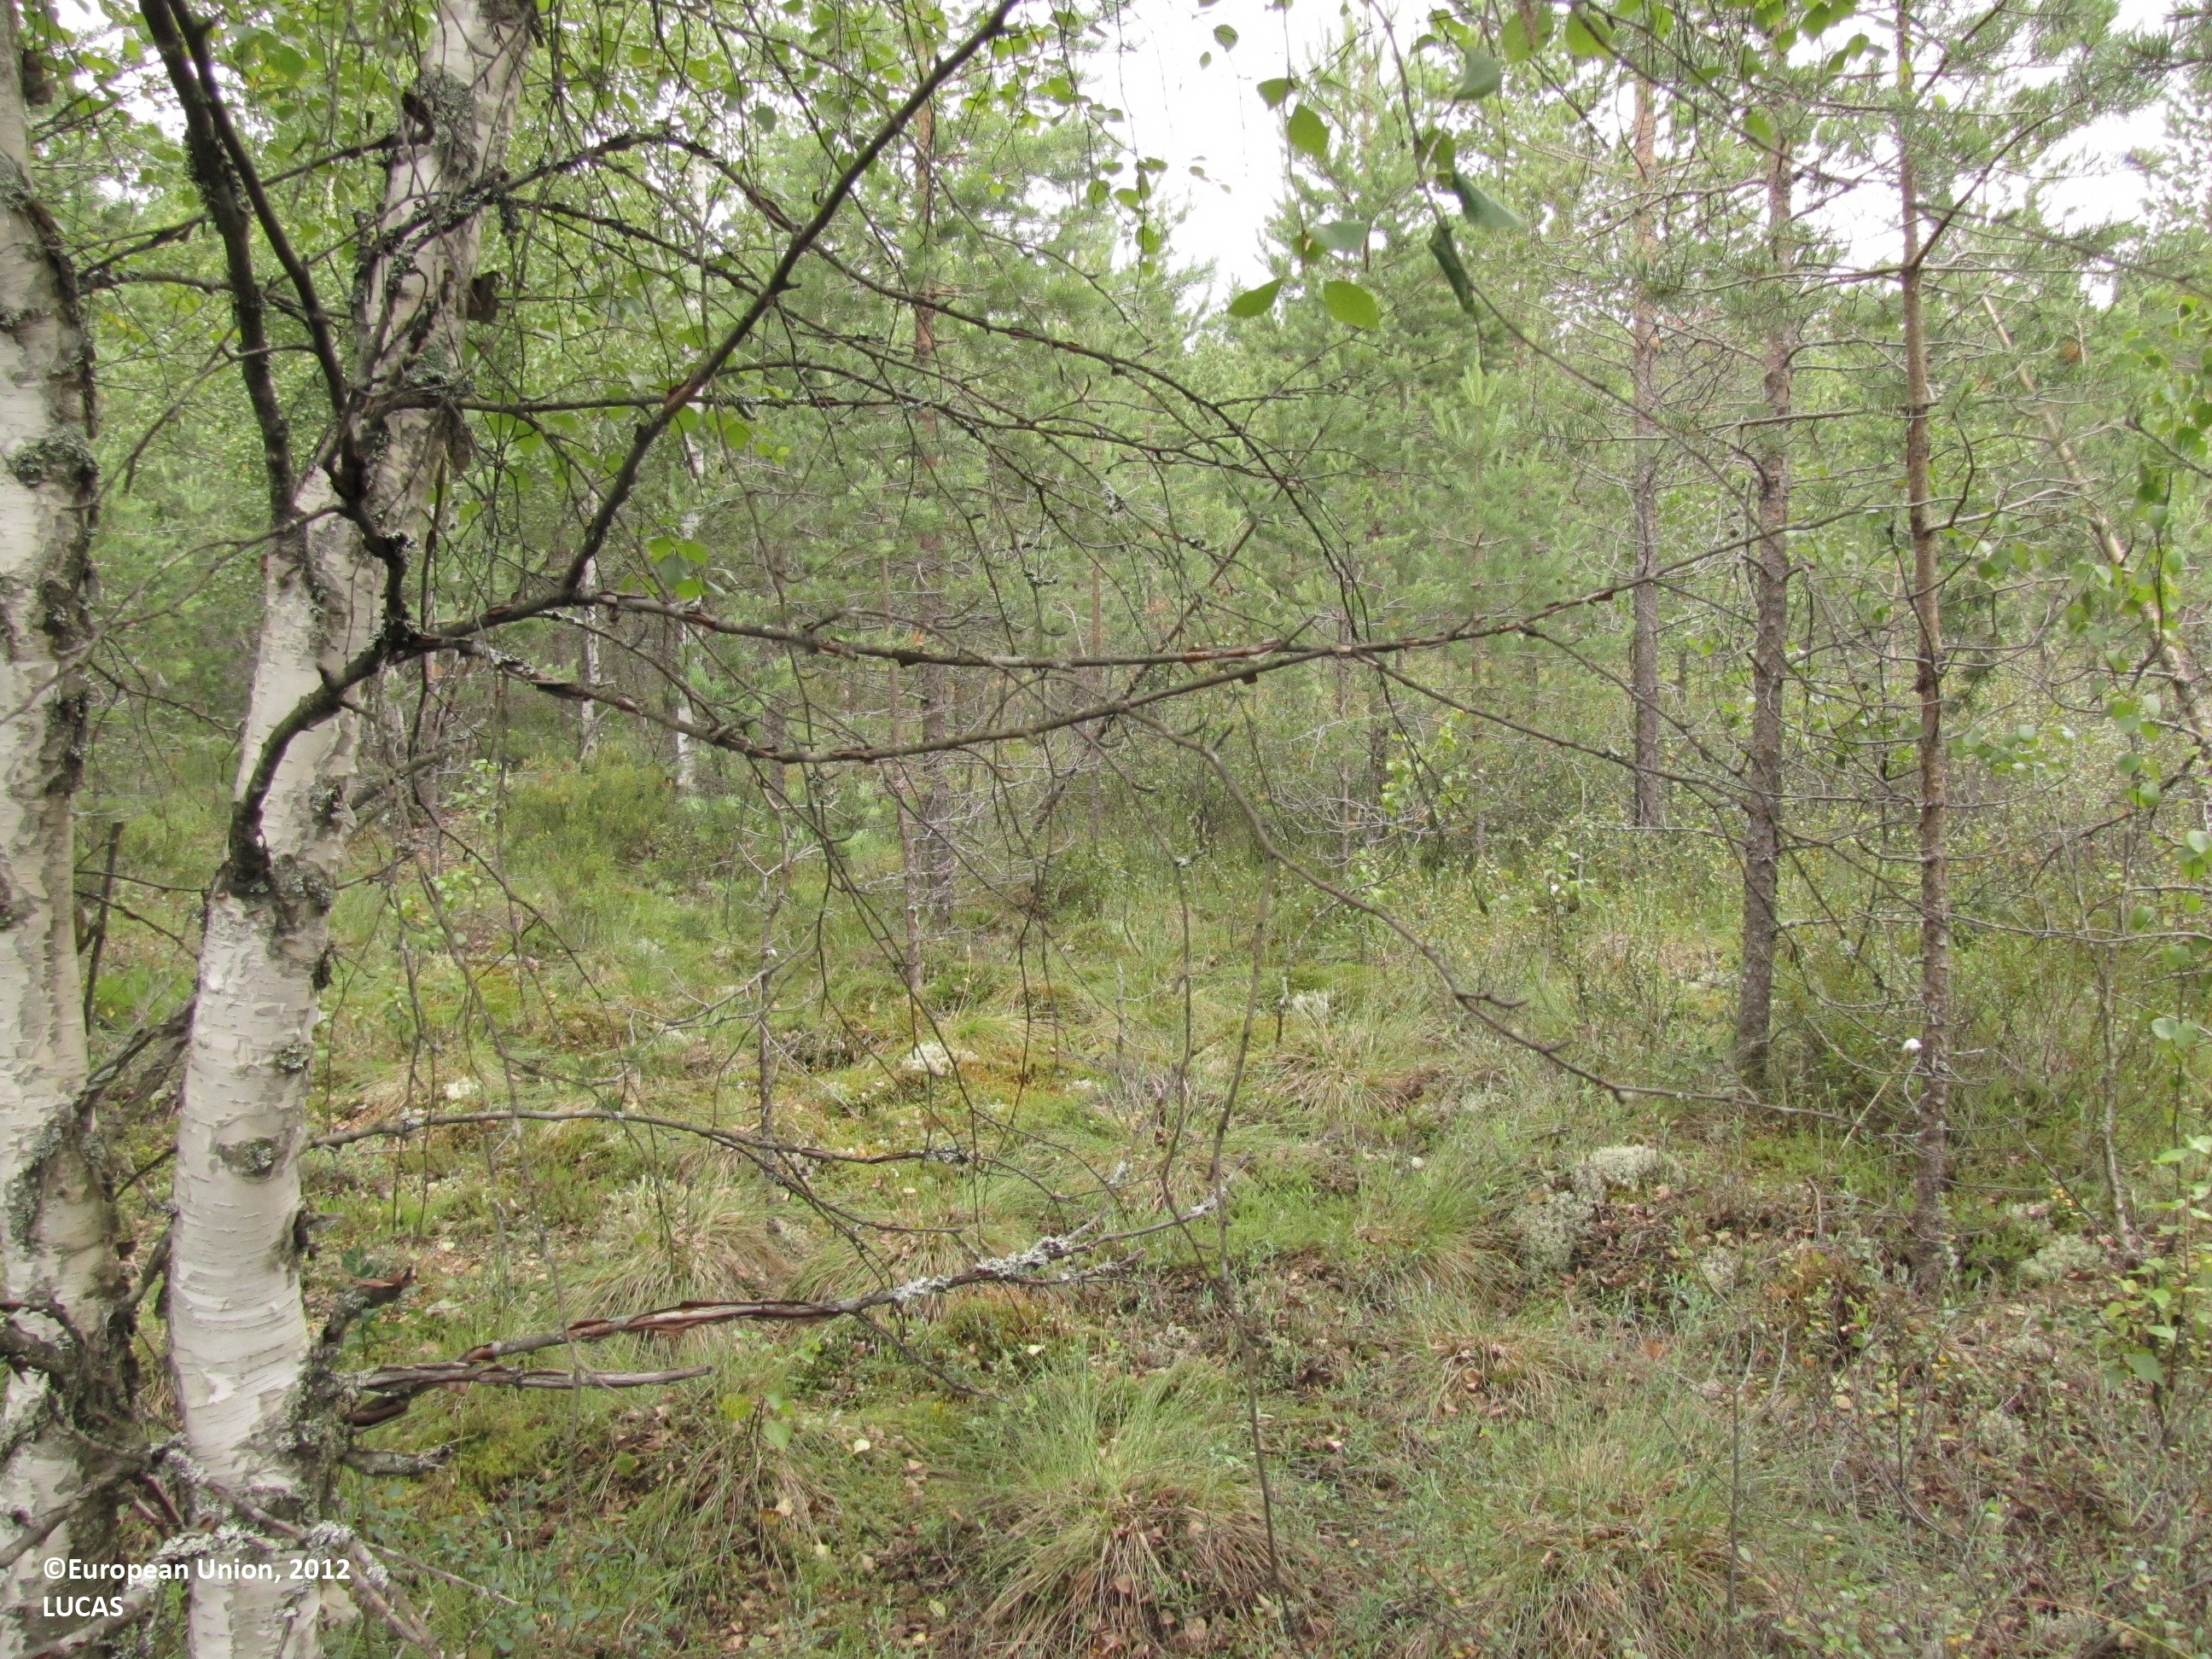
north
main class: Woodland
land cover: Pine dominated mixed woodland
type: mire and swamp forests
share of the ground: 25 - 50 %
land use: Forestry
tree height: > 5 m
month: July
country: FI
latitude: 62.2456
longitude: 23.0199
